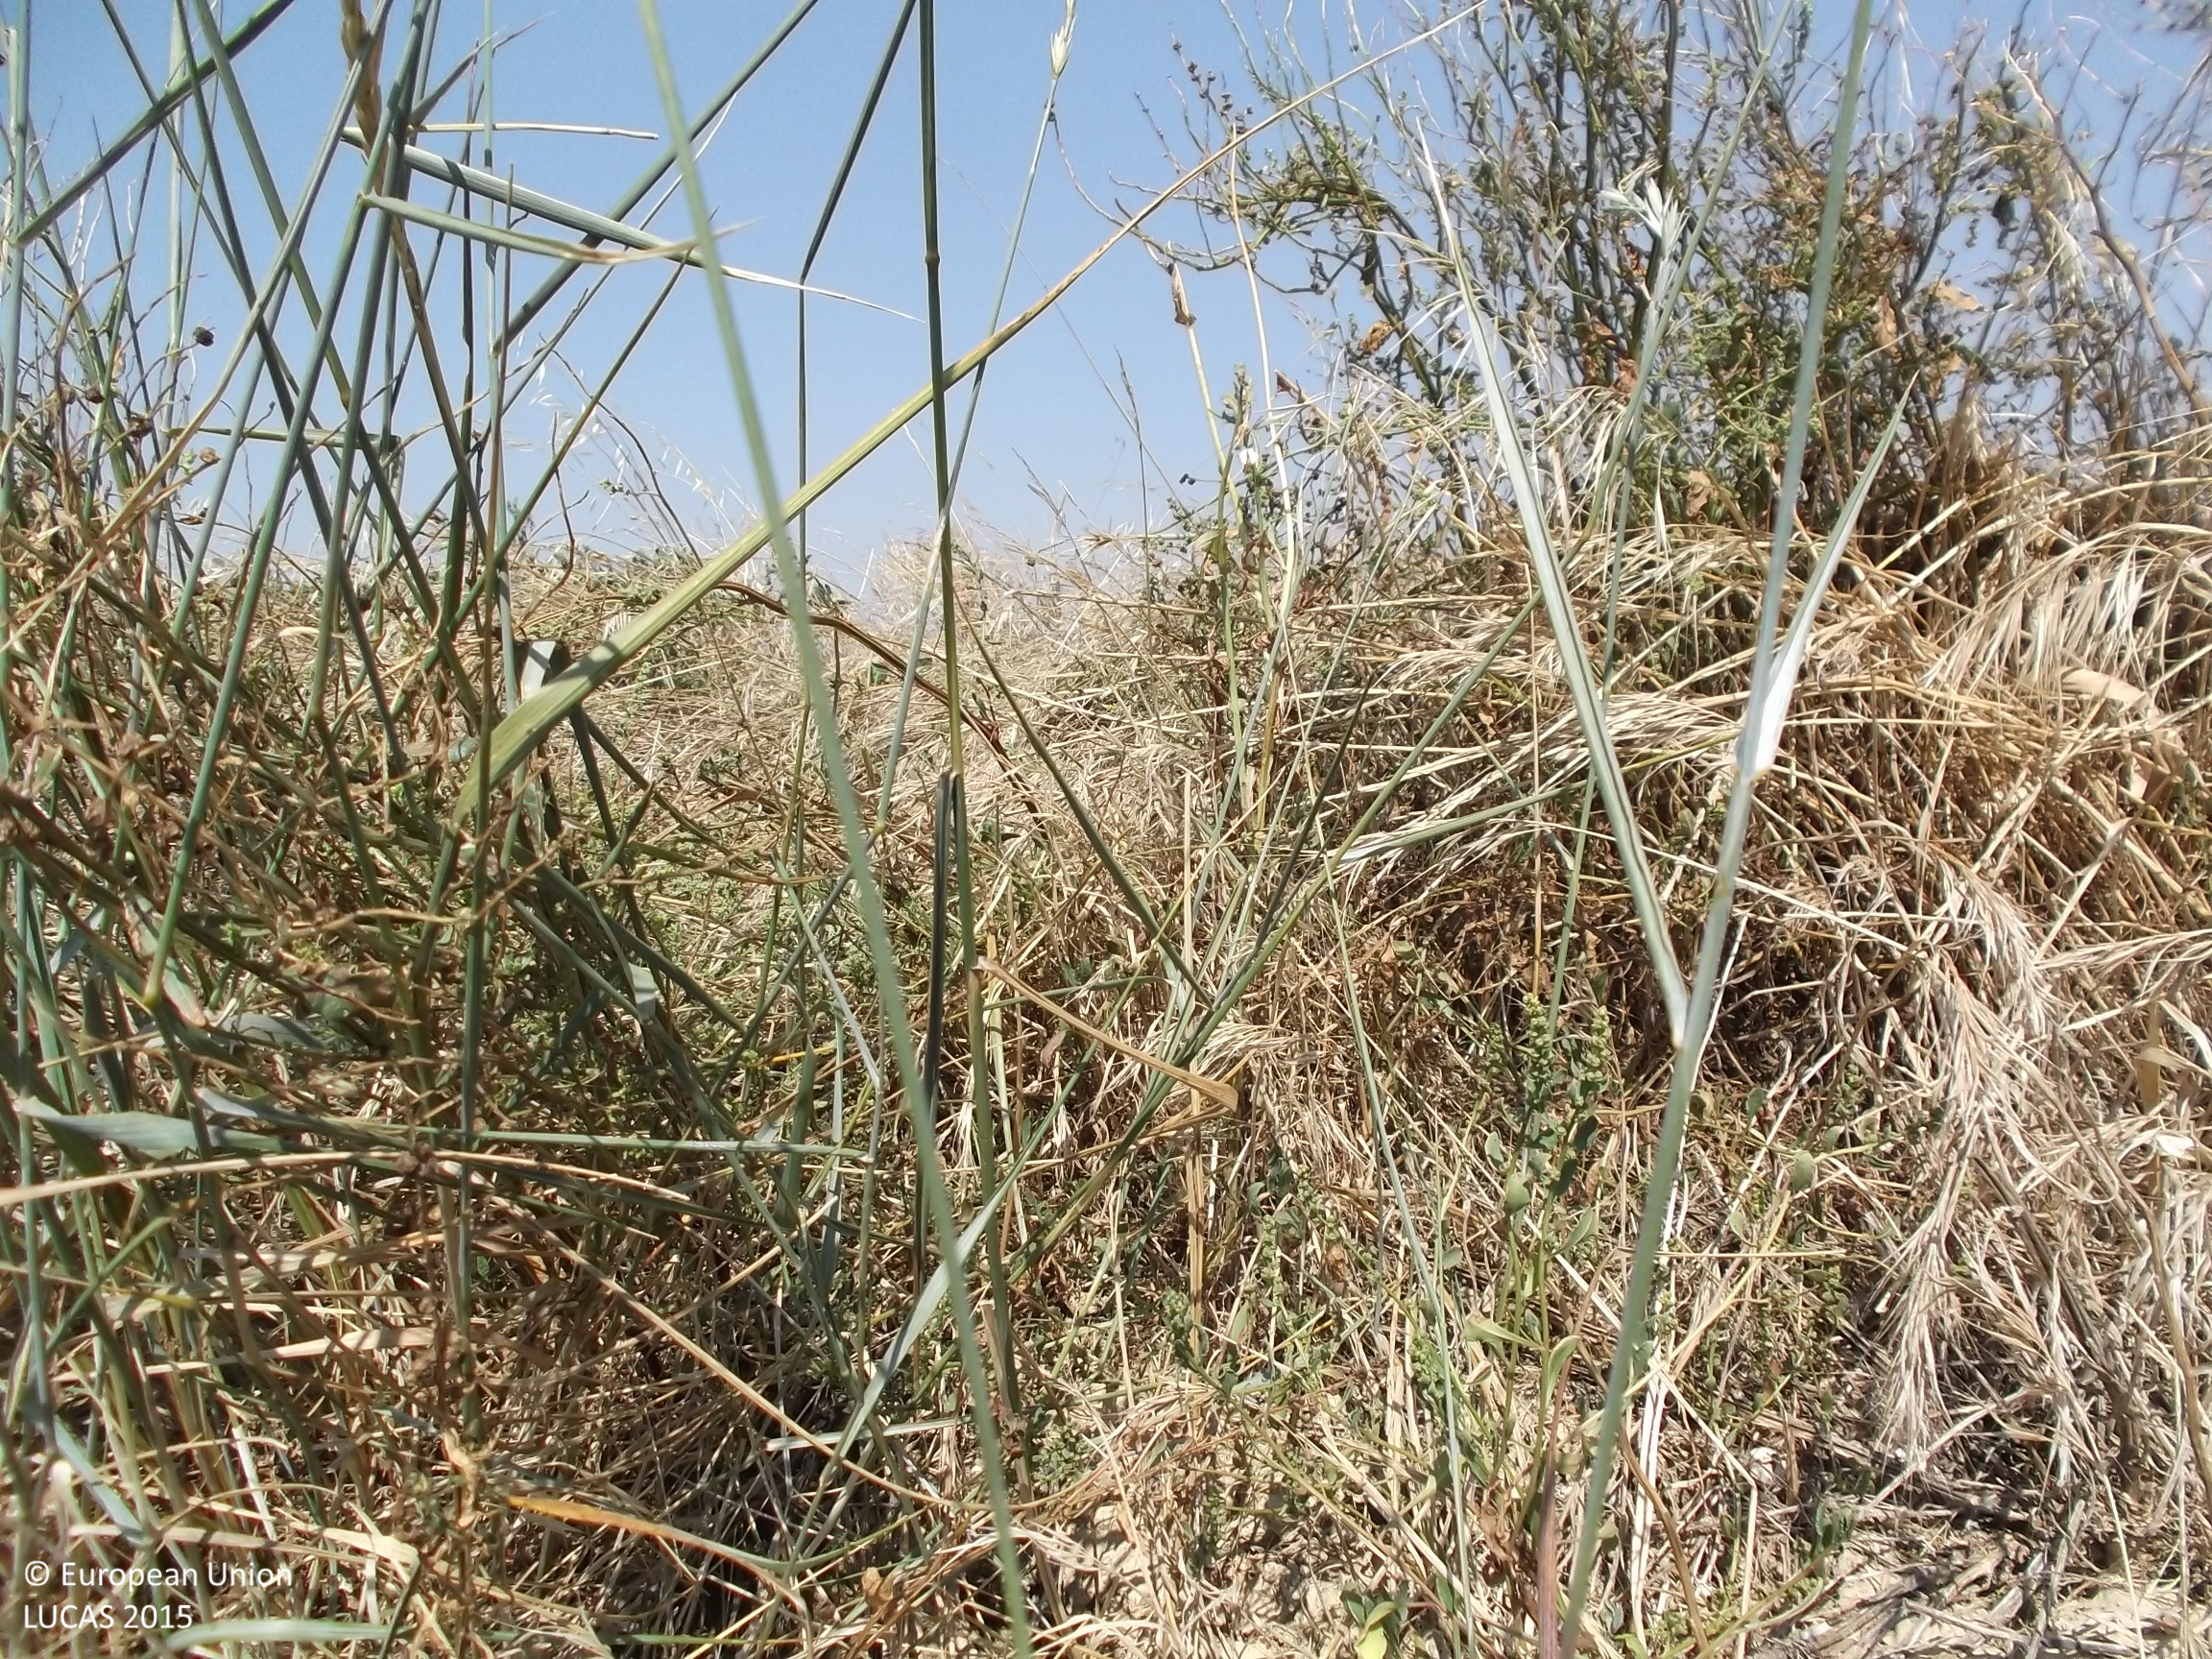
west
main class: Grassland
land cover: Grassland without tree/shrub cover
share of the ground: > 75 %
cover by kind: herbaceous plants 95 %
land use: Semi-natural and natural areas not in use
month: July
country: ES
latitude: 42.4919
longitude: -1.6312
